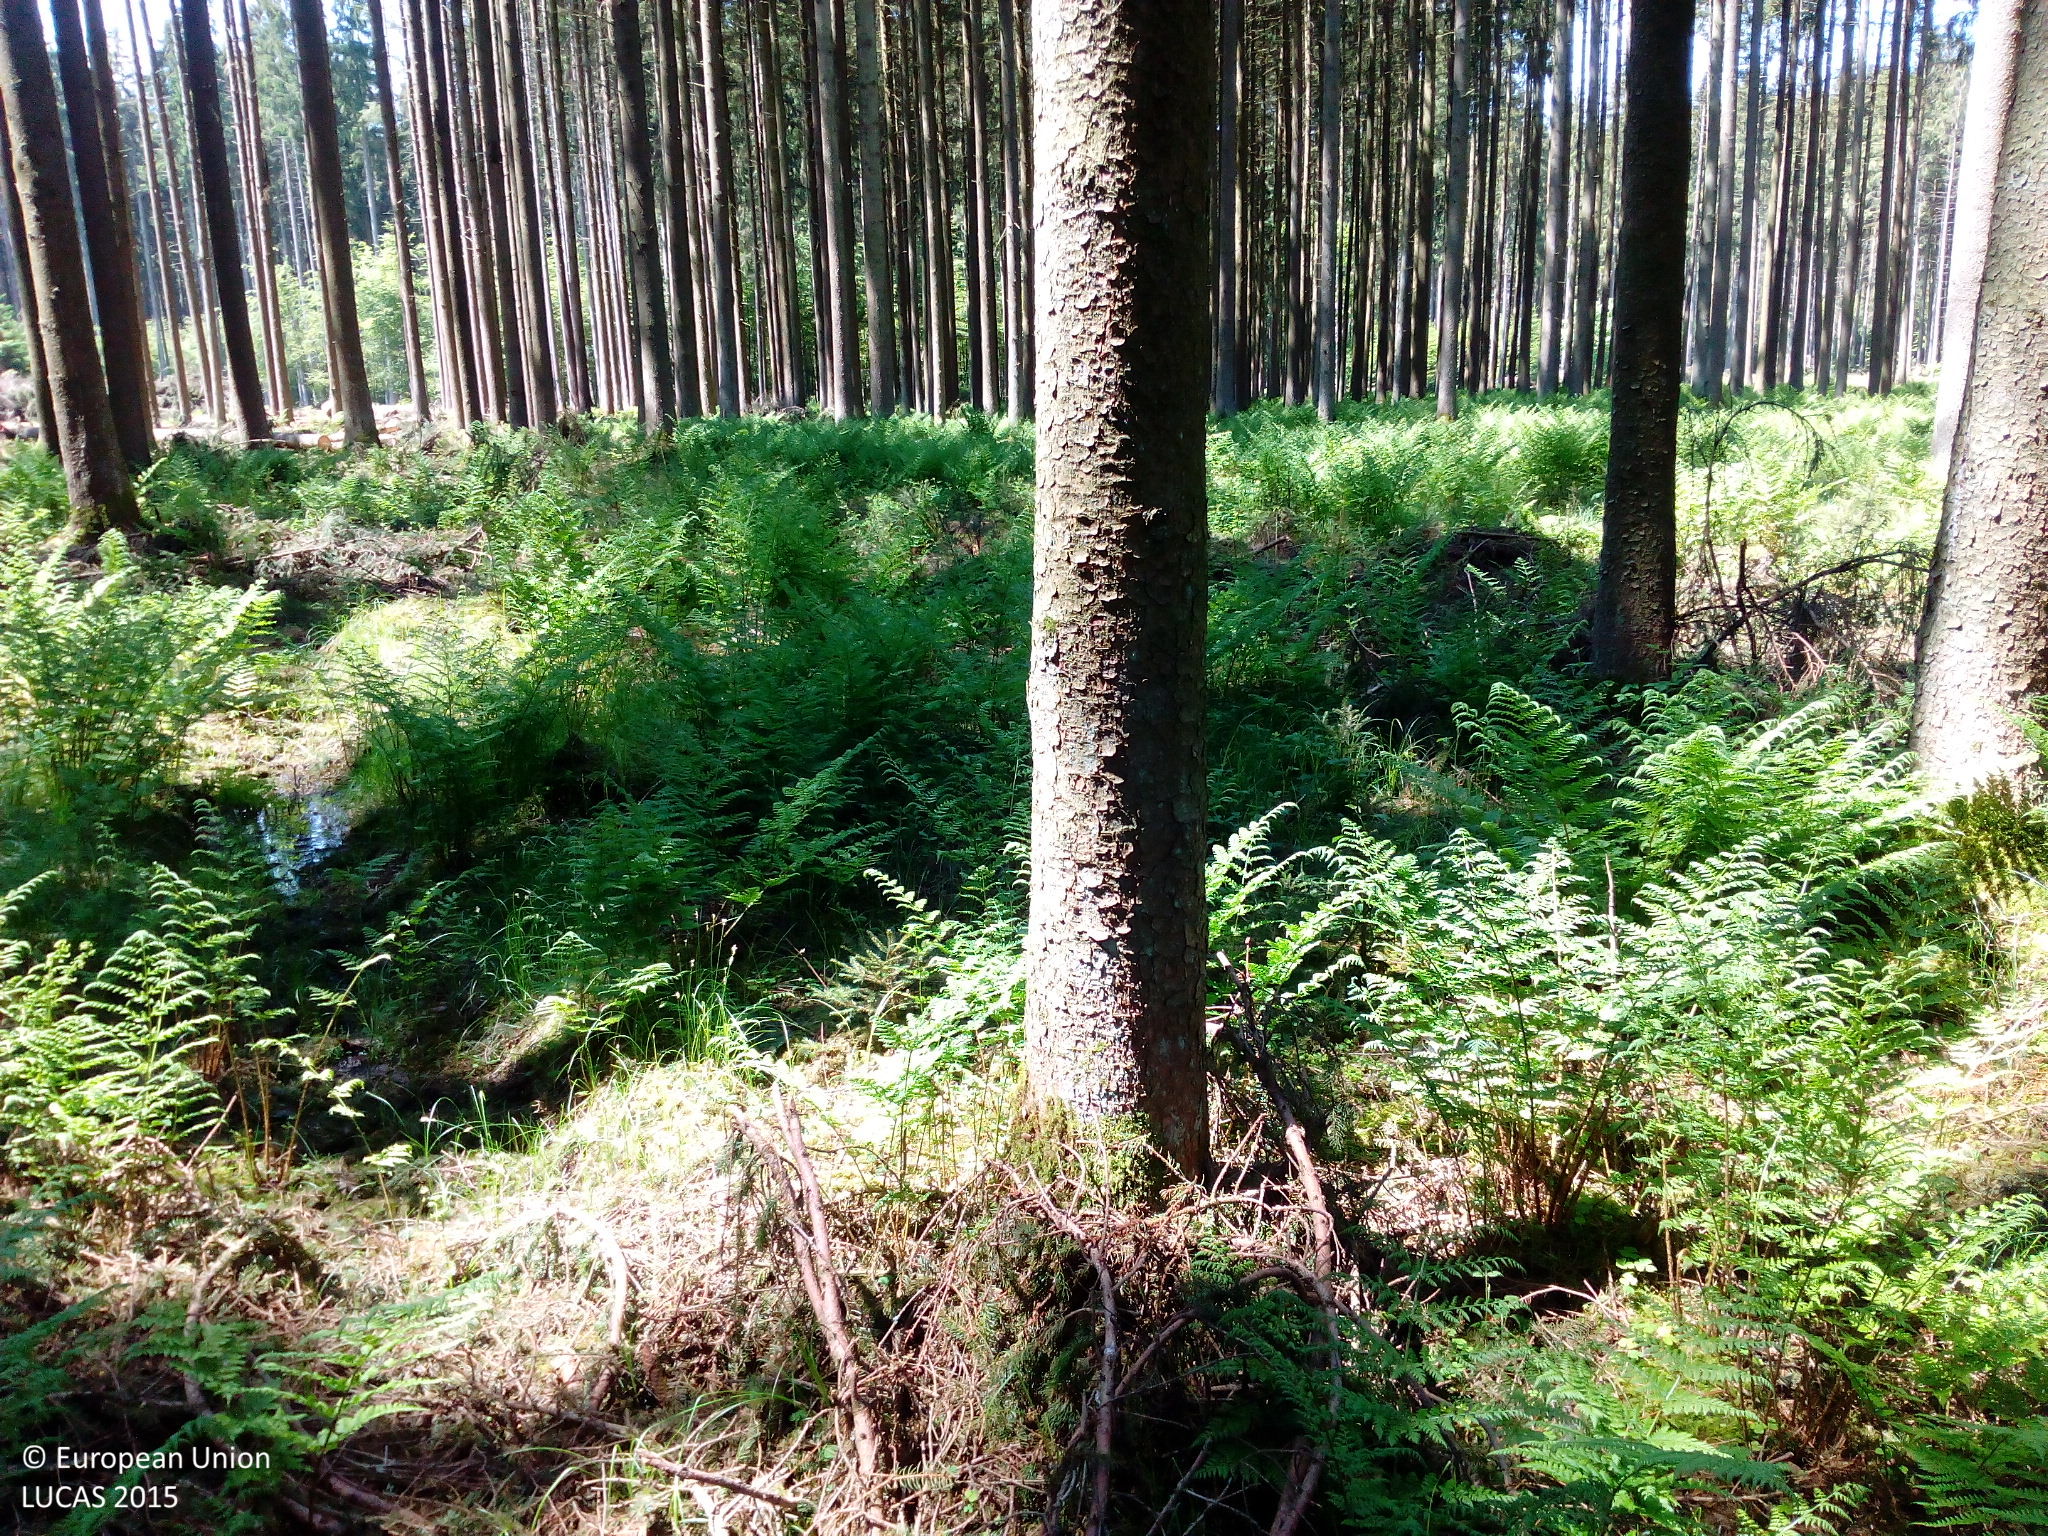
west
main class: Woodland
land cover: Spruce dominated coniferous woodland
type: hemiboreal forest and nemoral coniferous forest and mixed broadleaved-coniferous forest
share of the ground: > 75 %
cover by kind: coniferous forest trees 75 %, herbaceous plants 15 %, shrubs 10 %
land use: Forestry
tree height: > 5 m
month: May
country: DE
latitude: 48.2055
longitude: 9.9328
